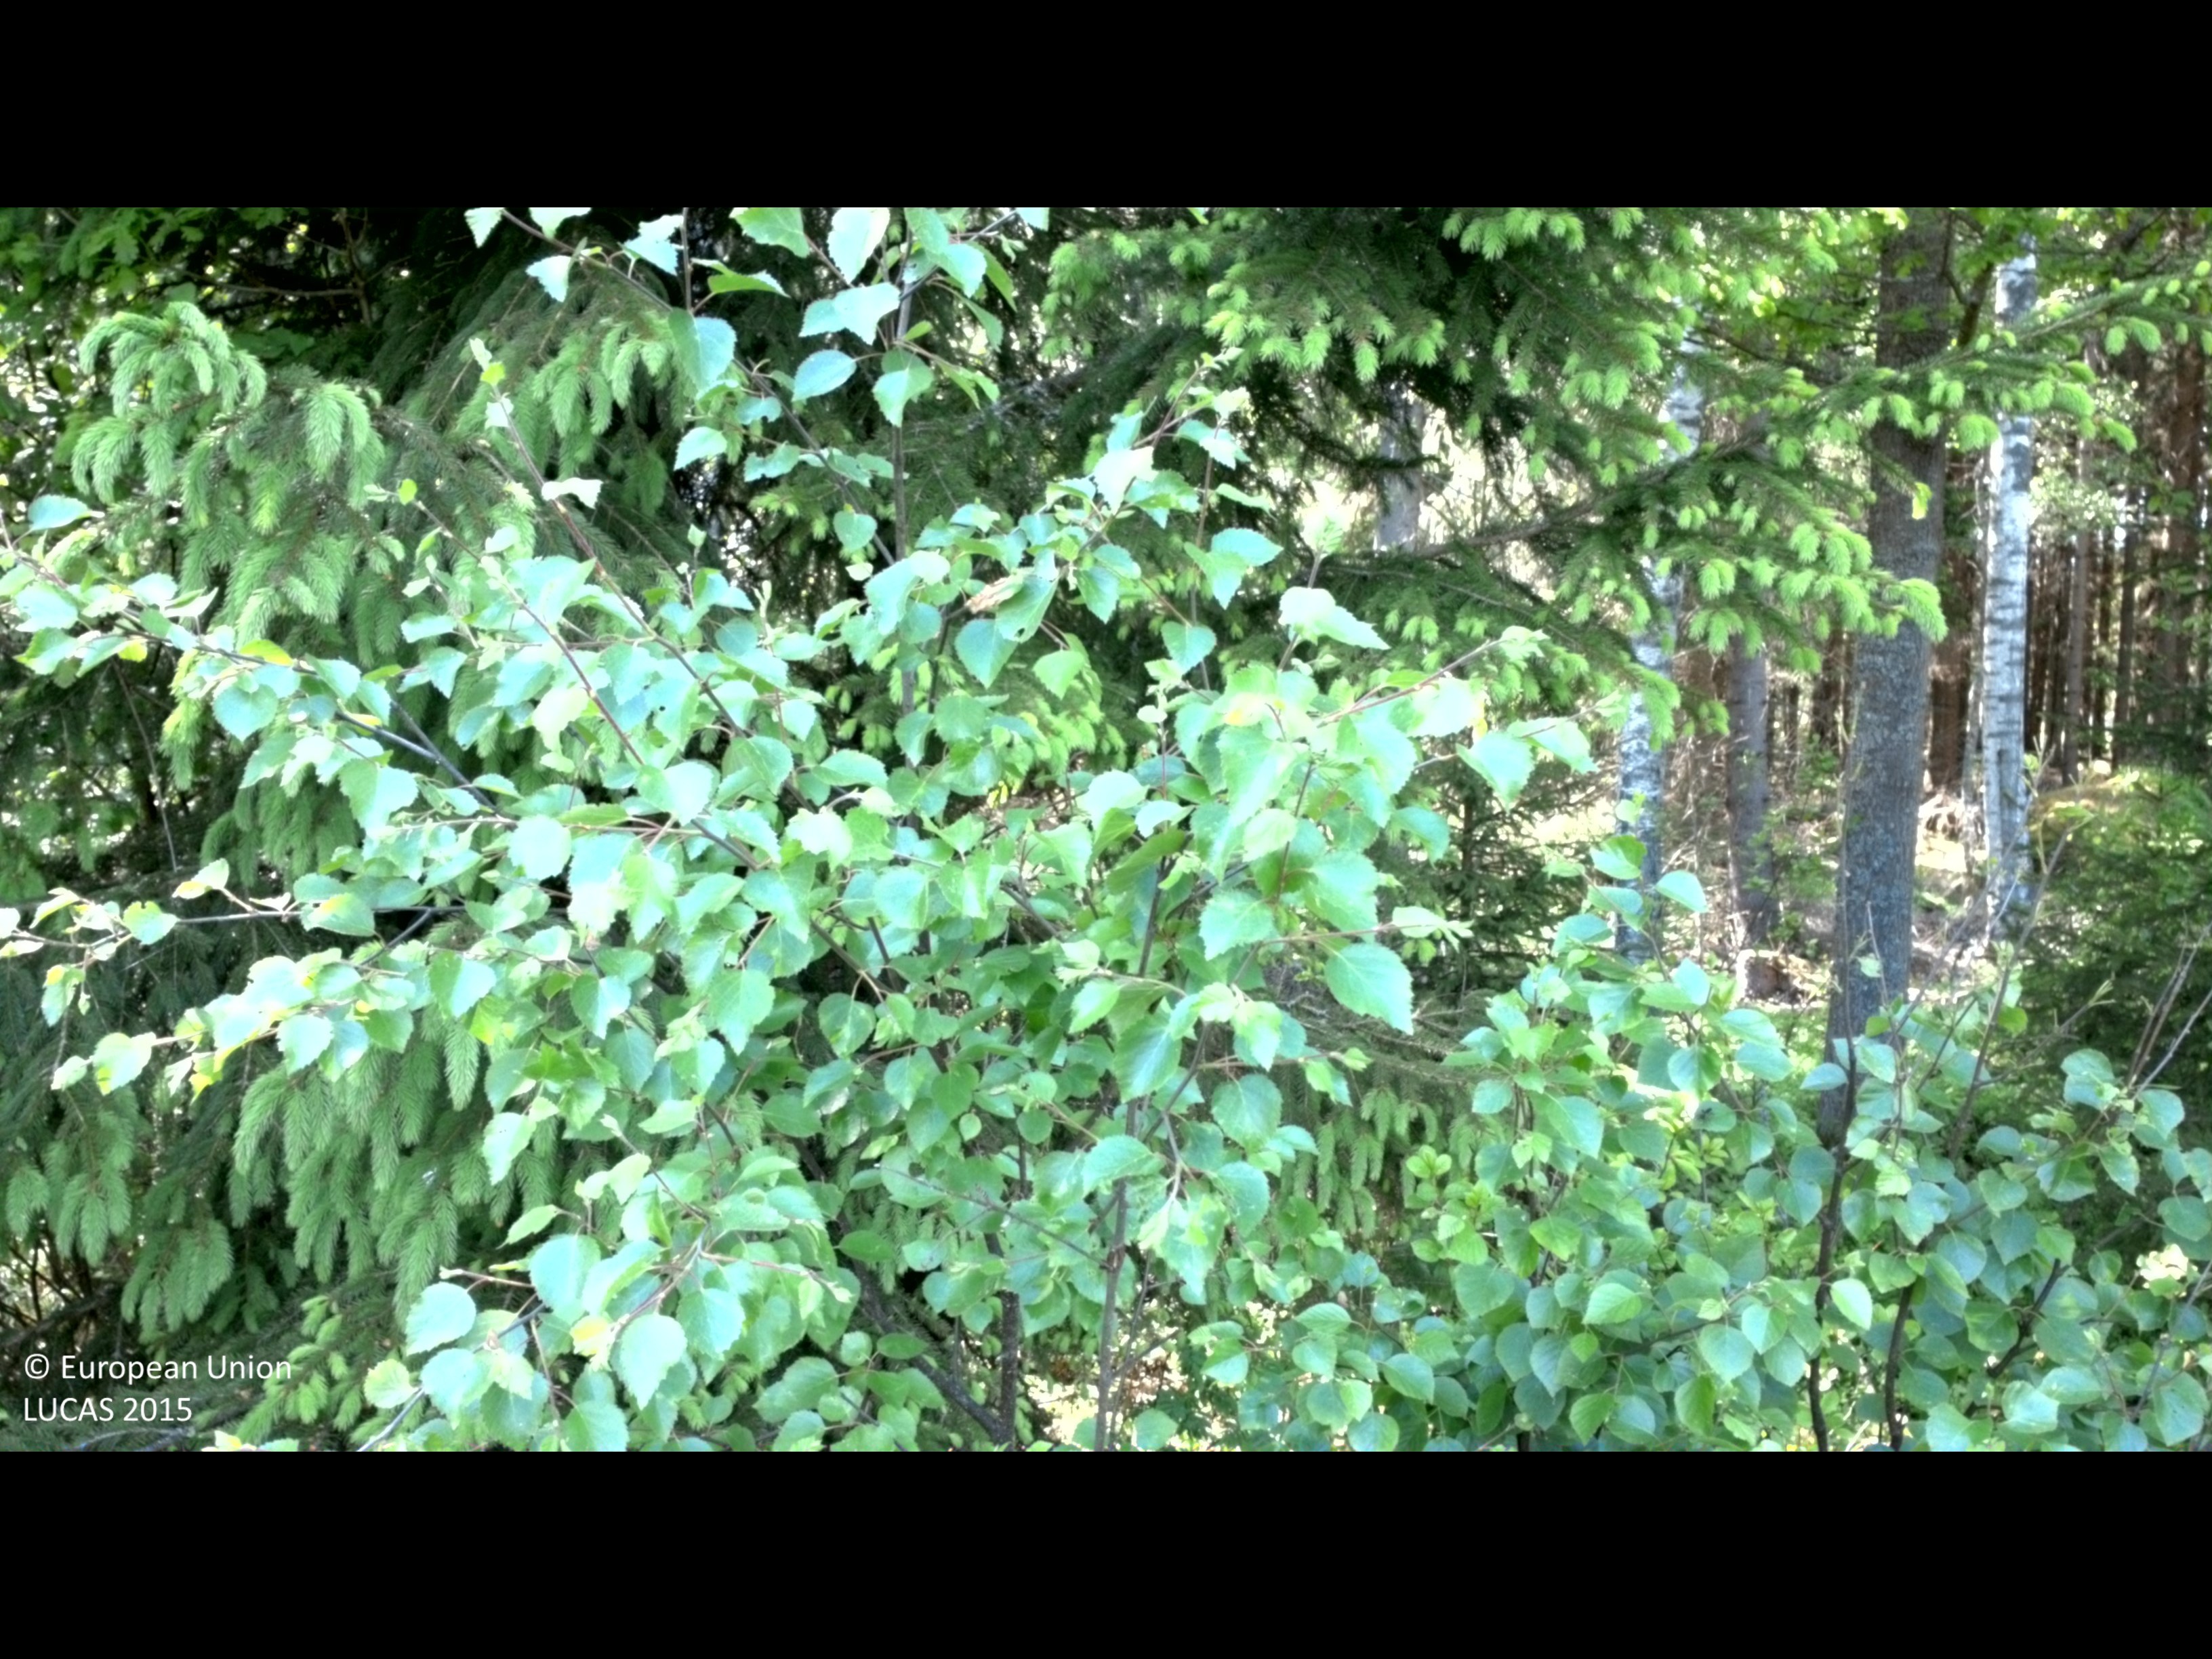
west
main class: Woodland
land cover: Broadleaved woodland
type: hemiboreal forest and nemoral coniferous forest and mixed broadleaved-coniferous forest
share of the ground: 25 - 50 %
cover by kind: shrubs 60 %, broadleaved forest trees 25 %, herbaceous plants 10 %
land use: Forestry
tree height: < 5 m
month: June
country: SE
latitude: 57.8055
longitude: 16.2070
